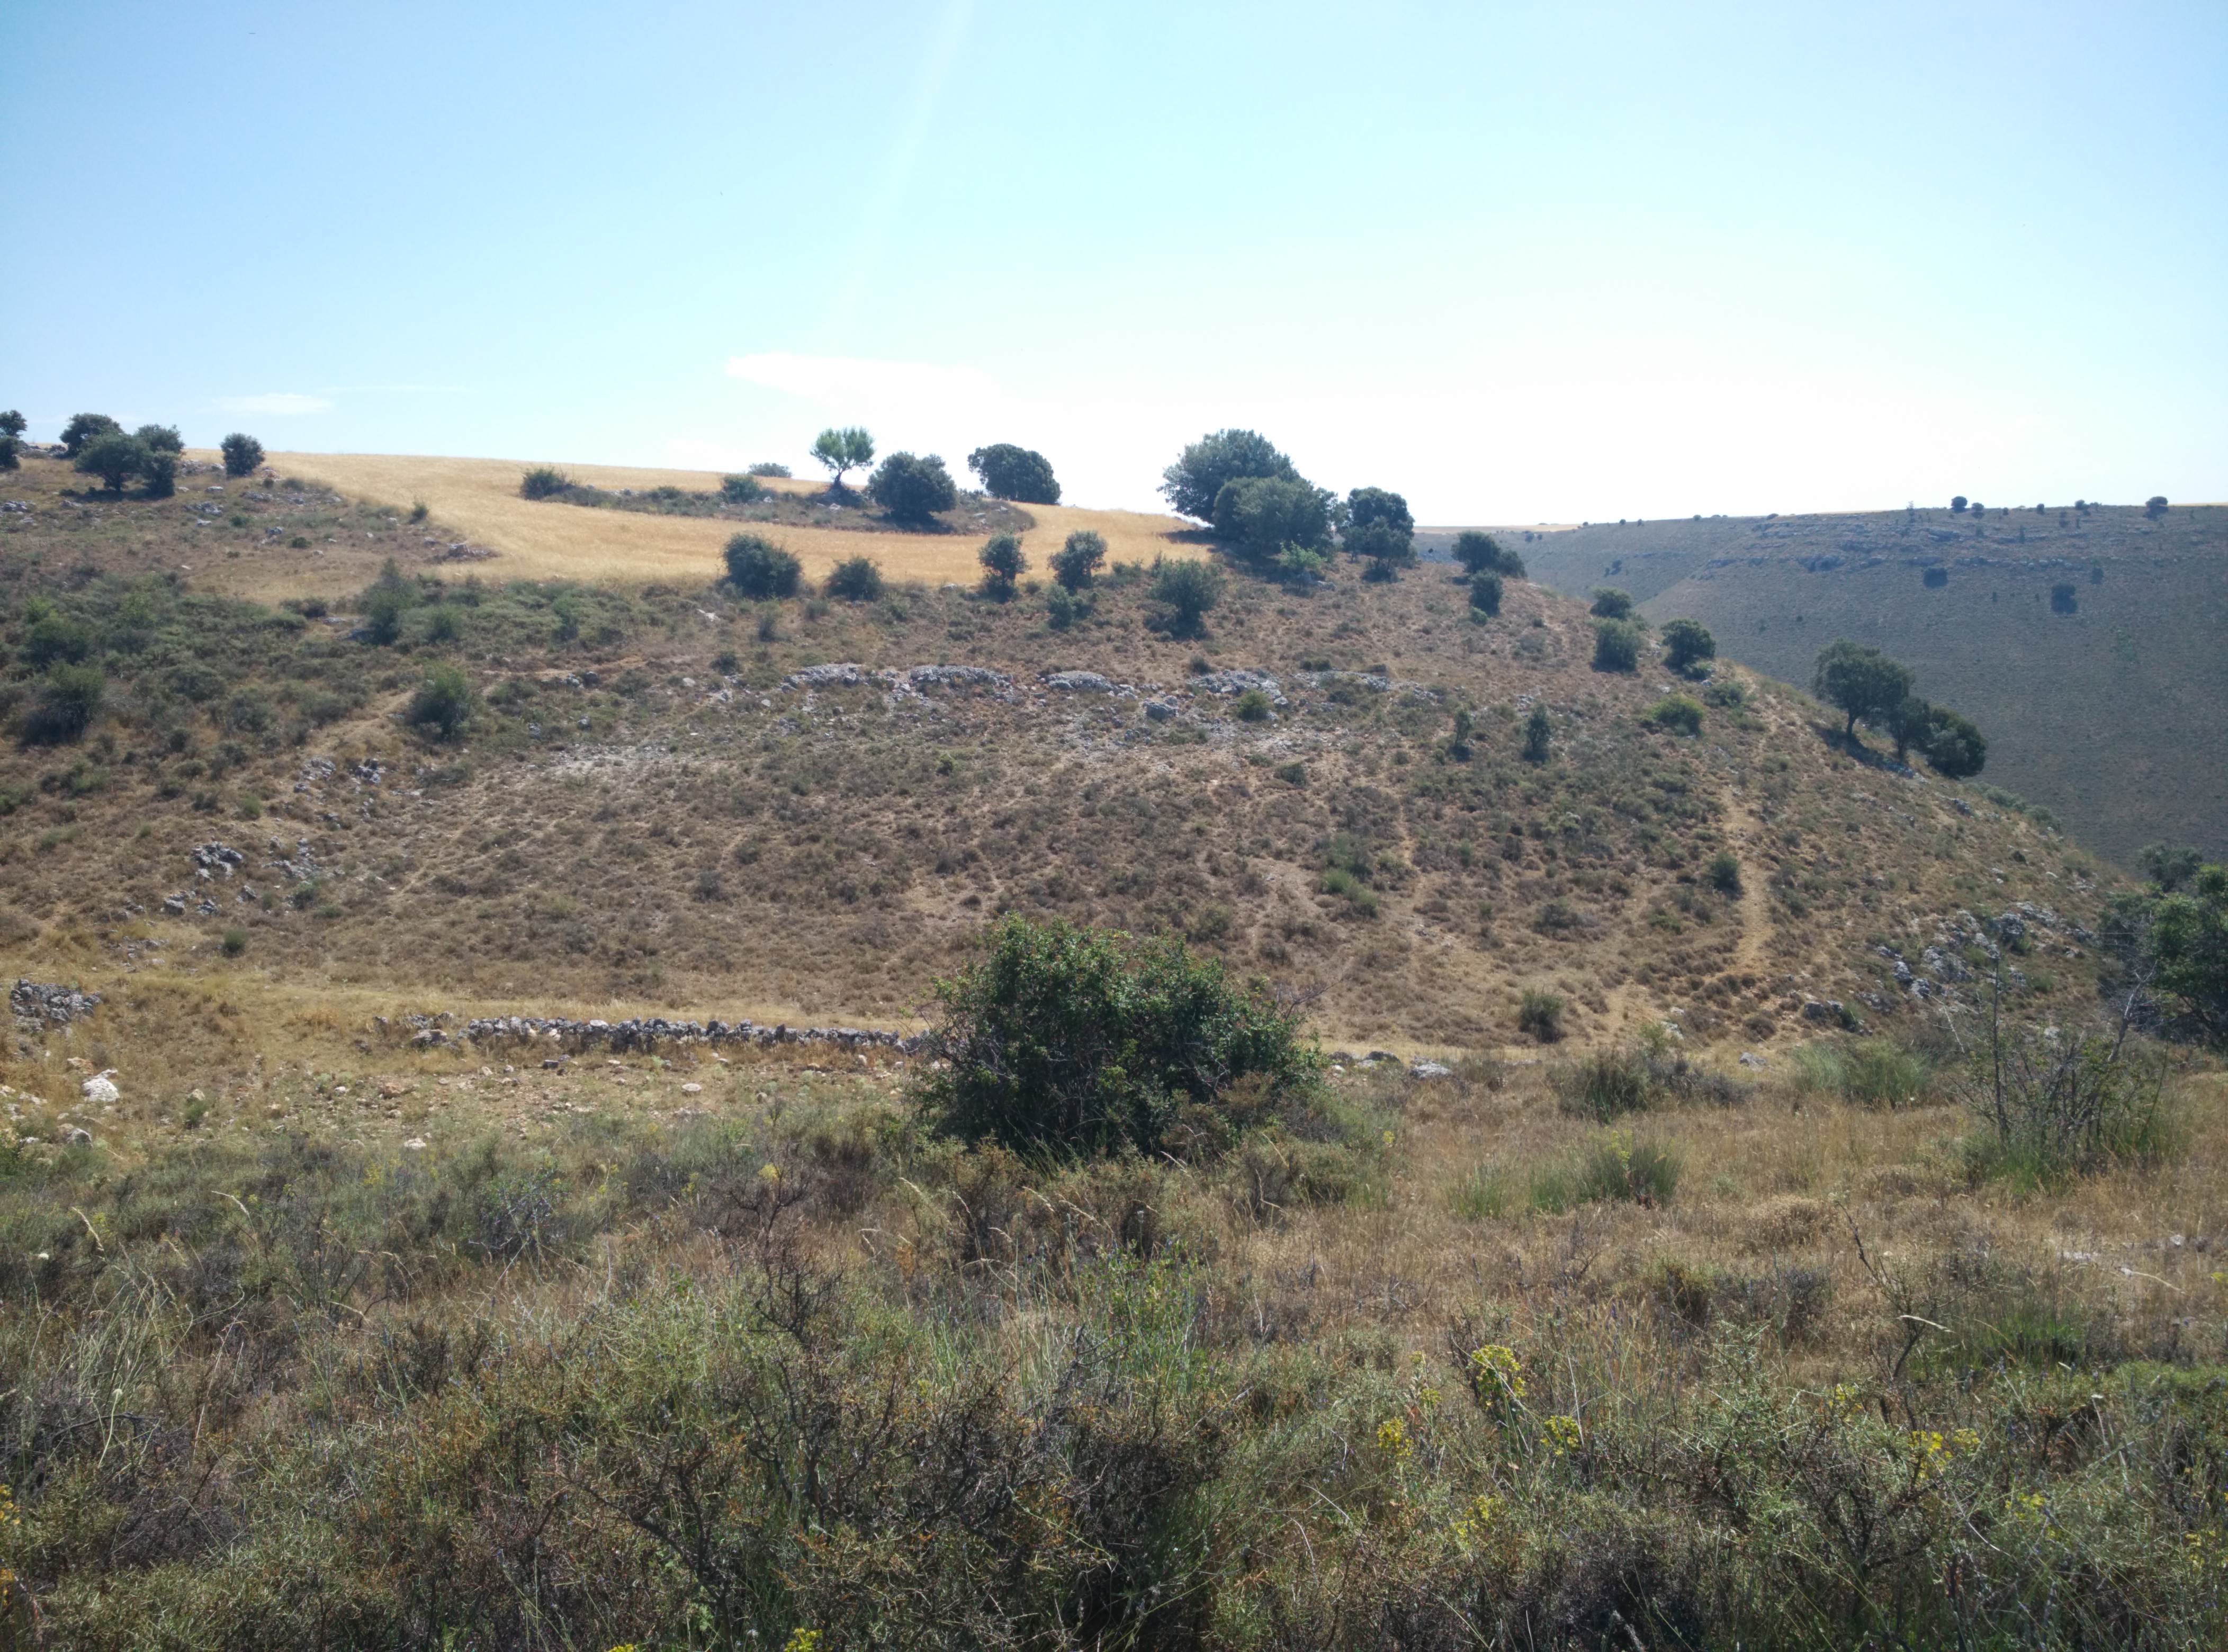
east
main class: Shrubland
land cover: Shrubland without tree cover
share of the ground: > 75 %
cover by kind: shrubs 85 %, unconsolidated bare surface 10 %, herbaceous plants 5 %
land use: Semi-natural and natural areas not in use
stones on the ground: > 50 %
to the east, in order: Shrubland without tree cover; Rocks and stones; Shrubland with sparse tree cover; Common wheat; Shrubland with sparse tree cover; Common wheat; Shrubland with sparse tree cover; Shrubland without tree cover
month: July
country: ES
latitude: 40.8918
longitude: -2.9114
